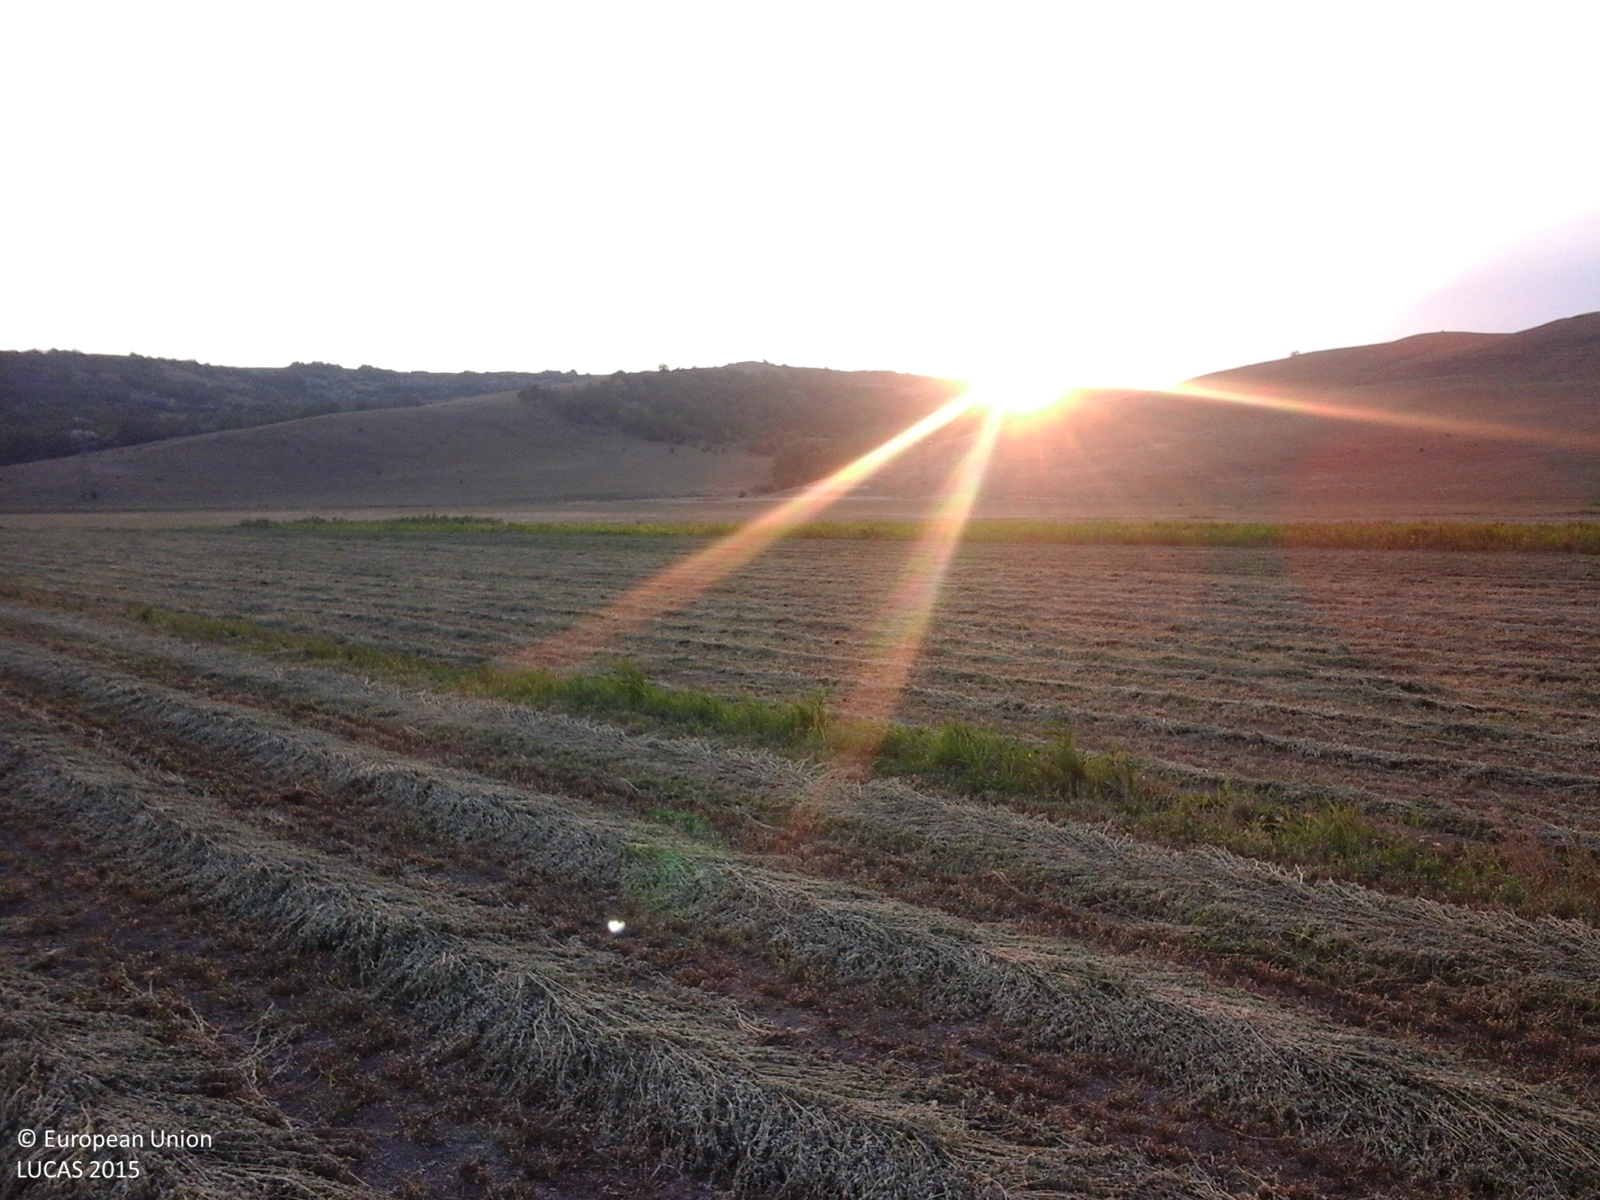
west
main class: Cropland
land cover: Lucerne
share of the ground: 25 - 50 %
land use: Agriculture (excluding fallow land and kitchen gardens)
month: June
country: RO
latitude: 46.8530
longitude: 27.7888
